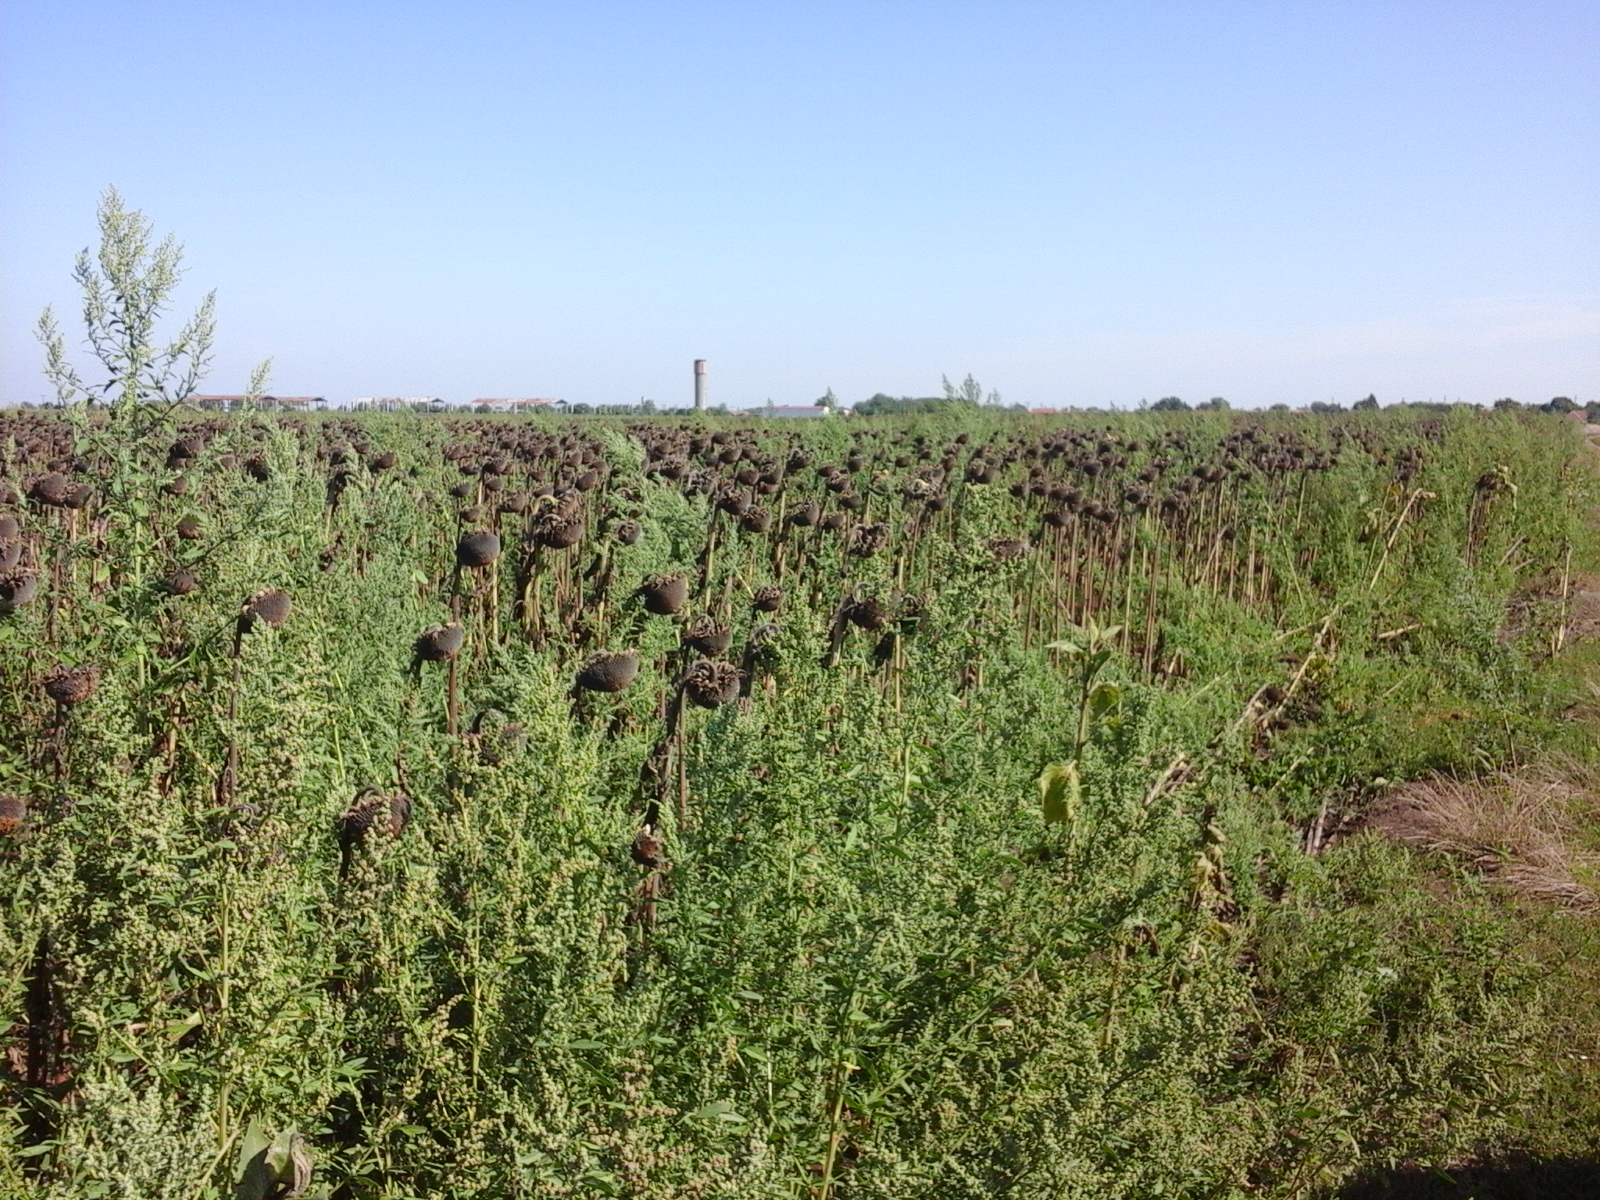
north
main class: Cropland
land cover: Sunflower
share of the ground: > 75 %
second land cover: Spontaneously vegetated surfaces
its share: 50 - 75 %
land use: Agriculture (excluding fallow land and kitchen gardens)
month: August
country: RO
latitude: 45.9013
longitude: 21.0760
